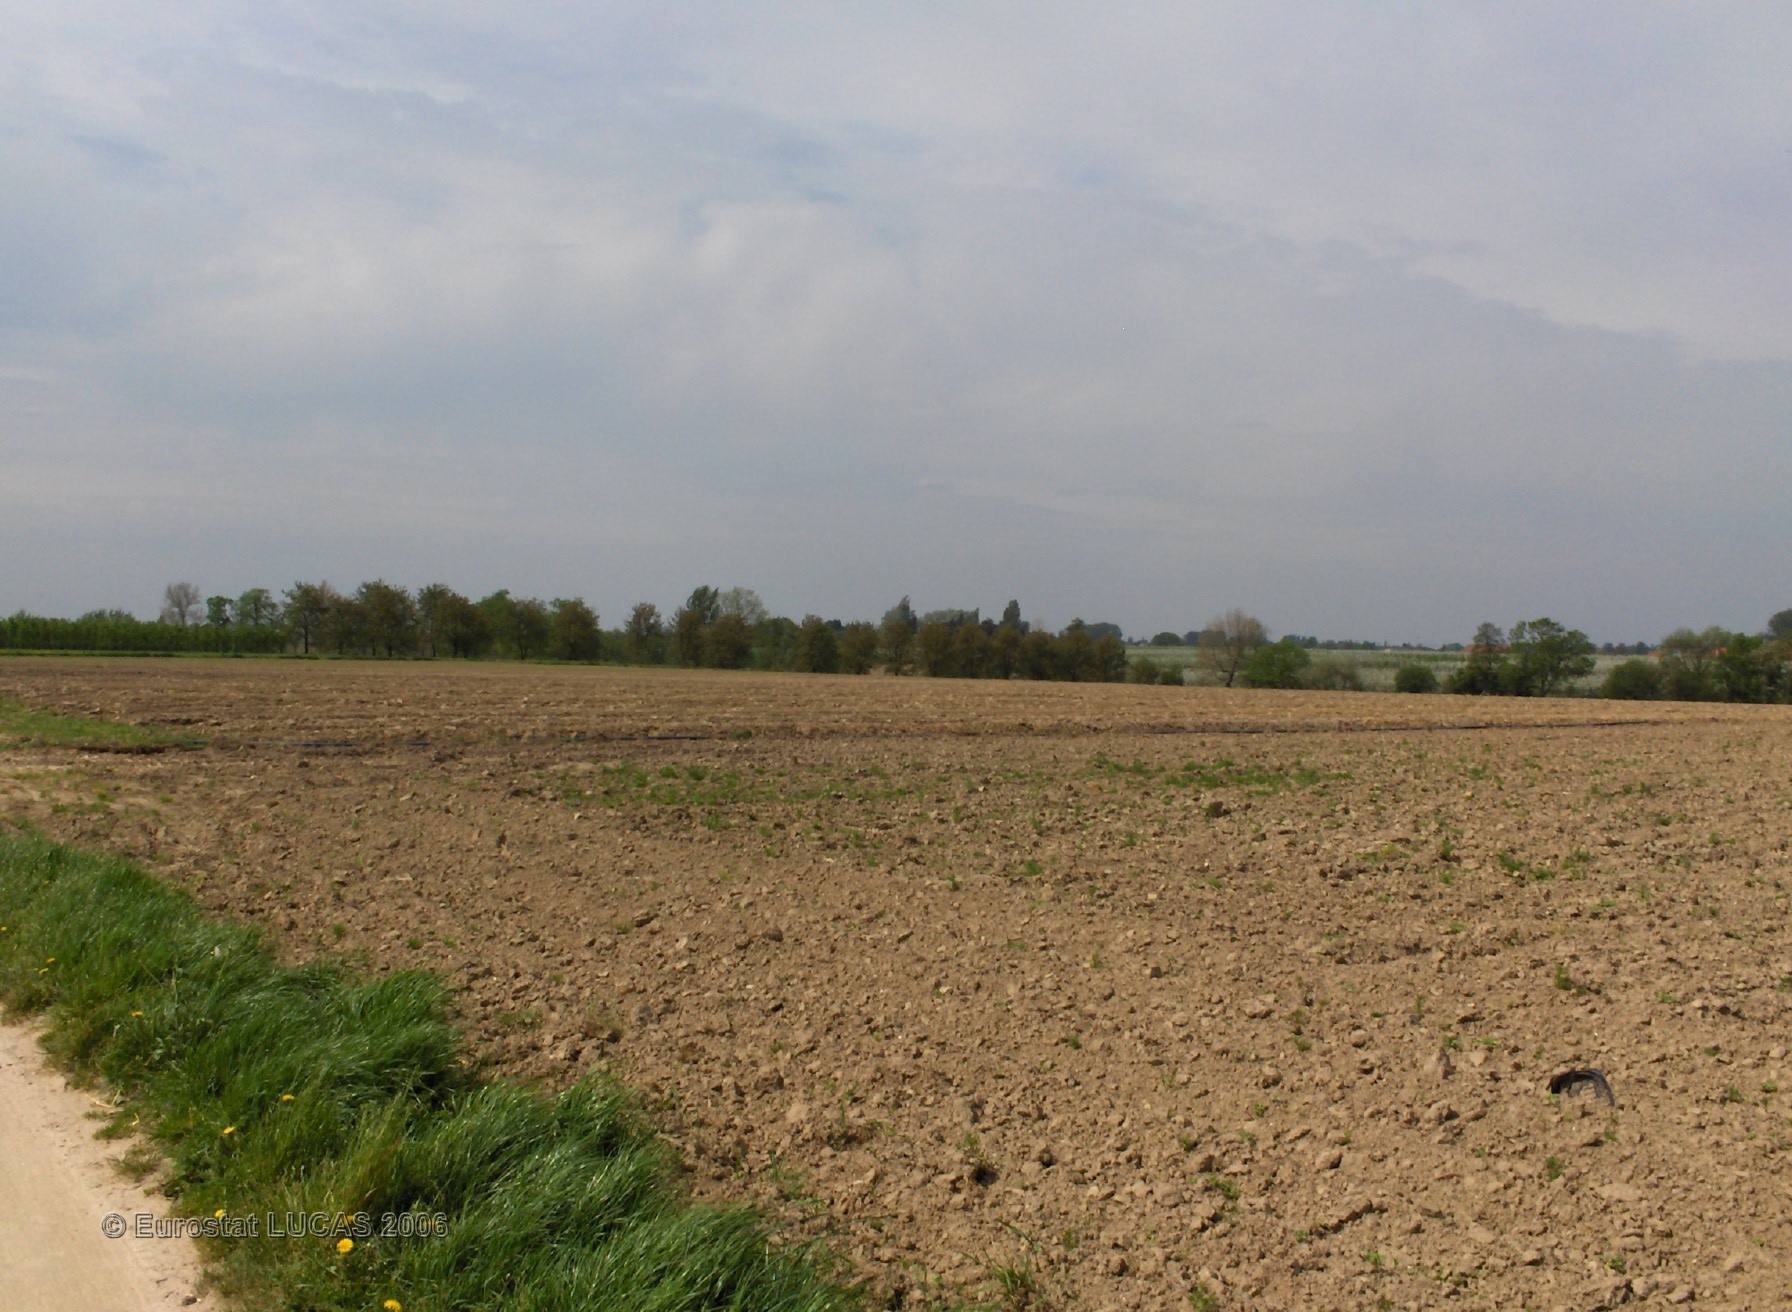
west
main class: Bare land
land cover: Bare land
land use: Agriculture (excluding fallow land and kitchen gardens)
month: May
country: BE
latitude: 50.9131
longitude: 5.2329
